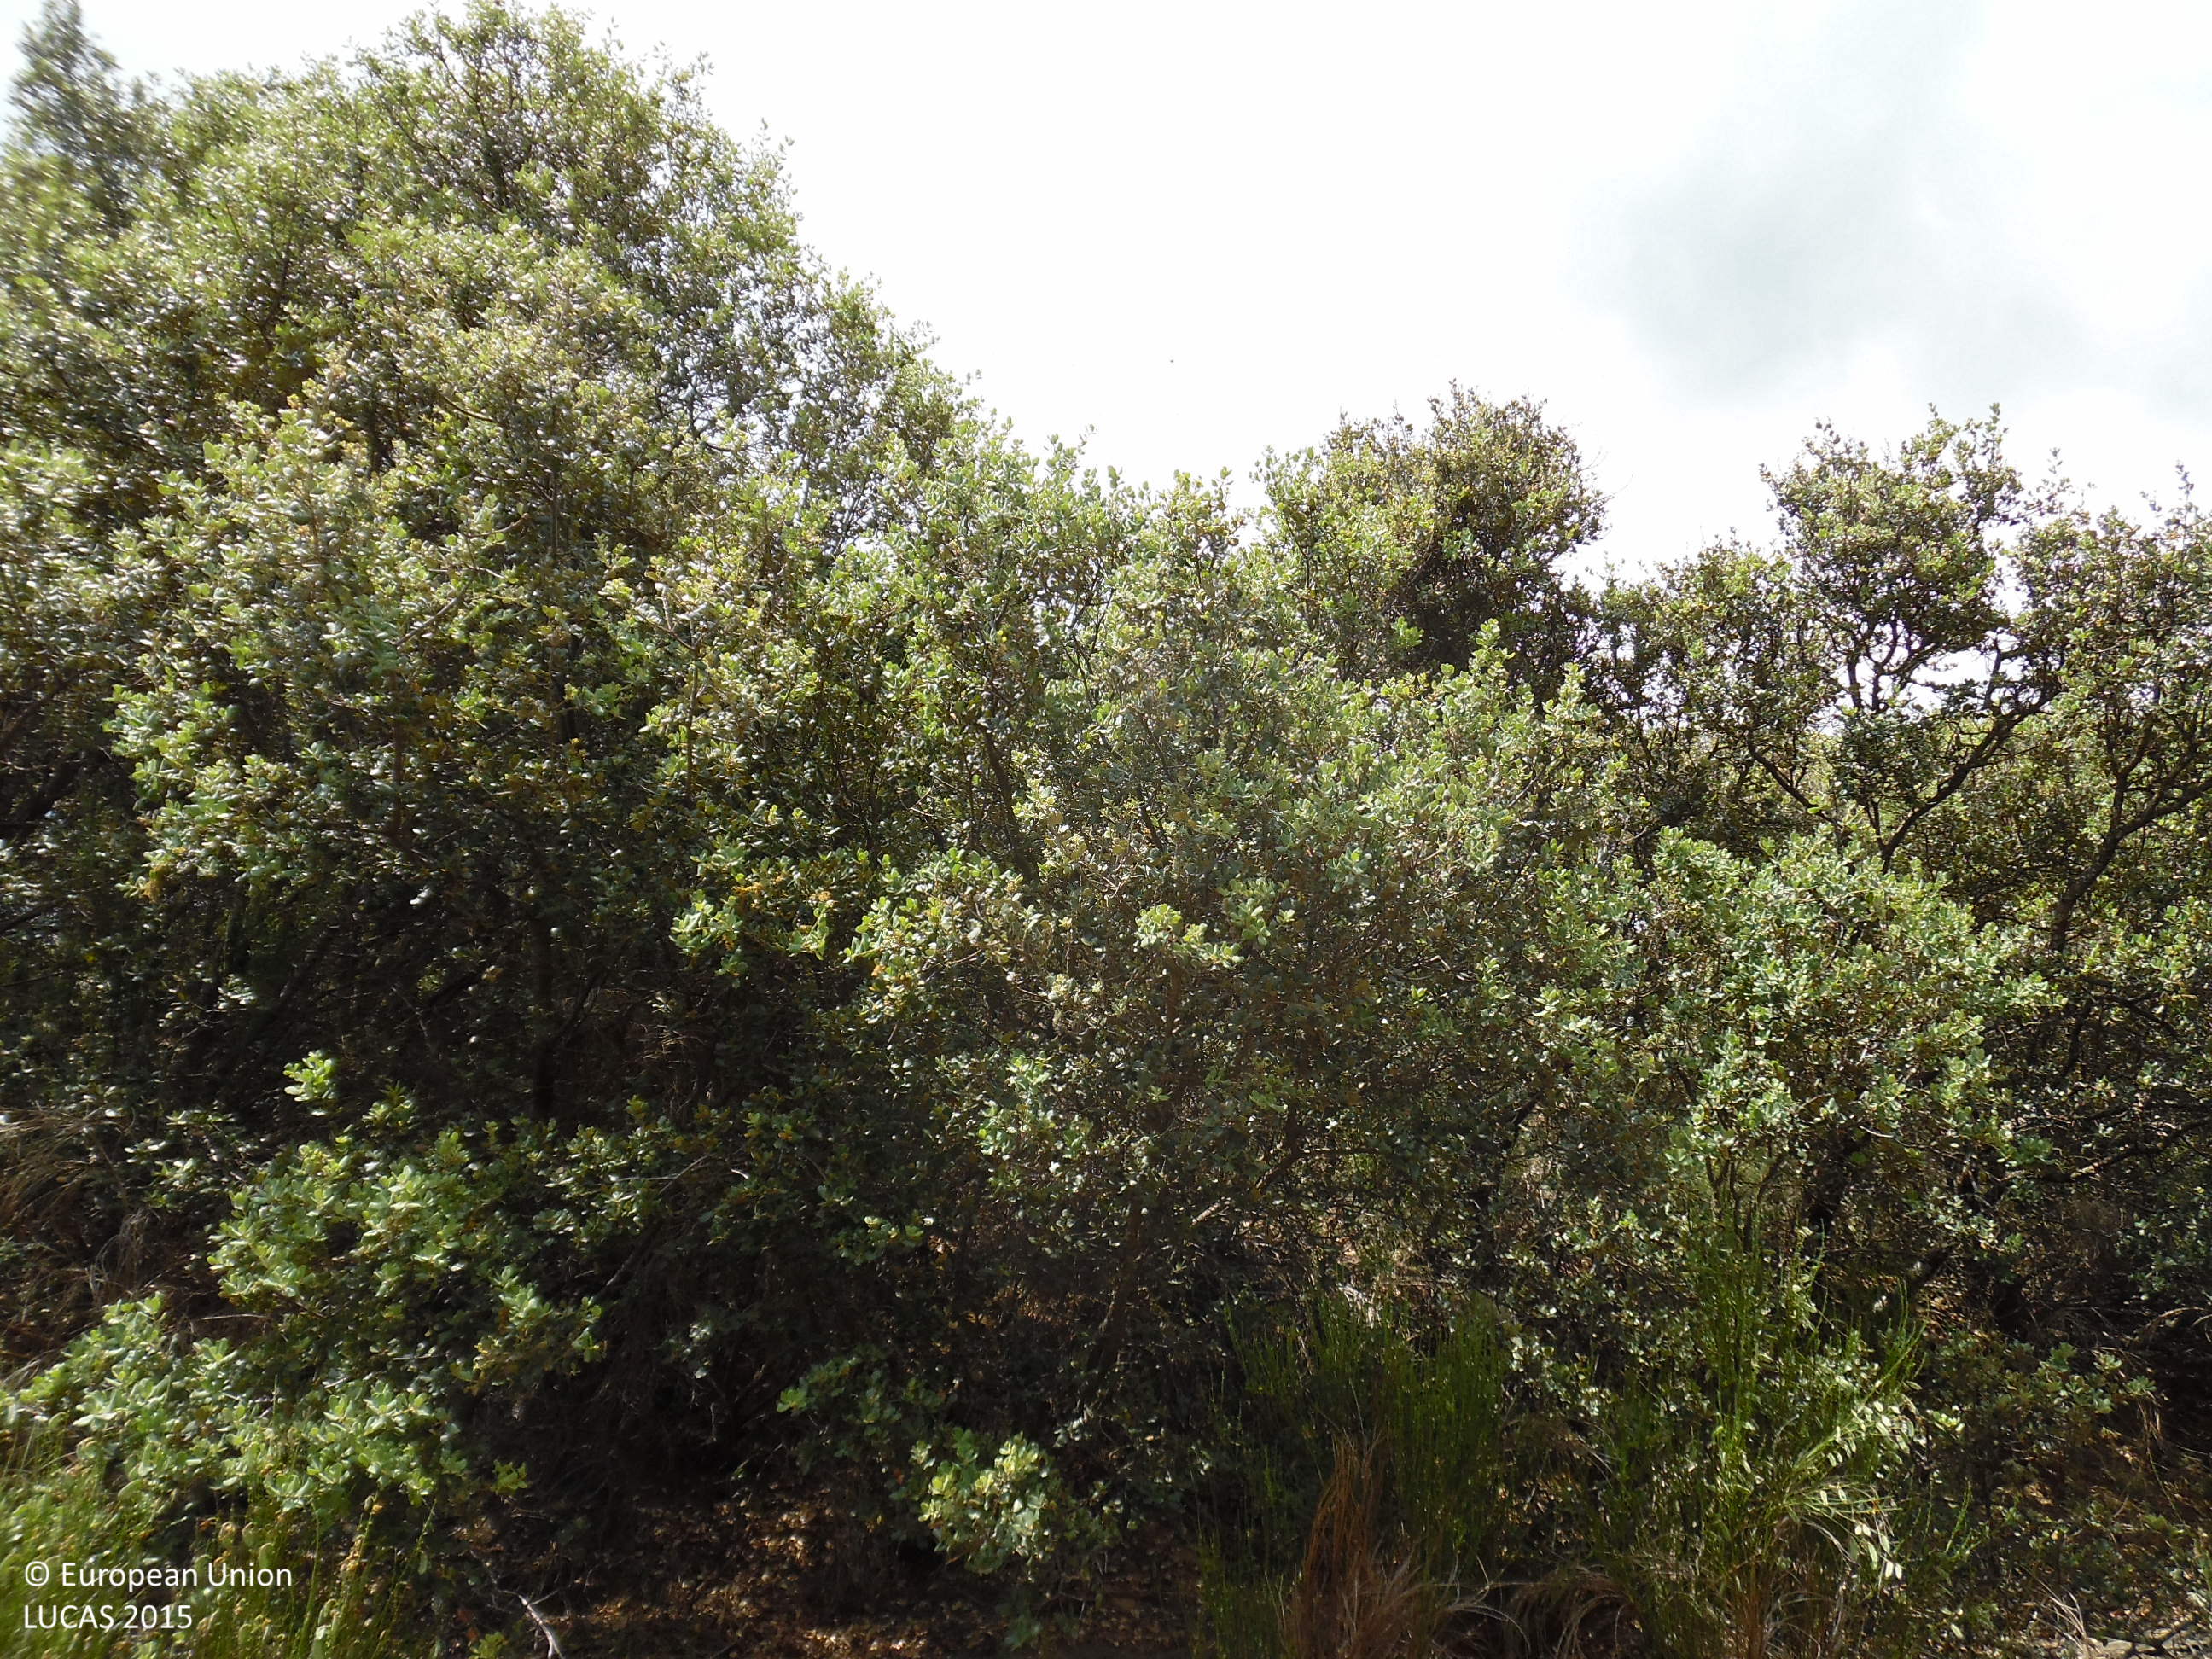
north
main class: Woodland
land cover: Broadleaved woodland
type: broadleaved evergreen forest
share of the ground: > 75 %
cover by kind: broadleaved forest trees 95 %, shrubs 5 %
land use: Forestry
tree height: > 5 m
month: June
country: ES
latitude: 42.2639
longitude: -6.6156
